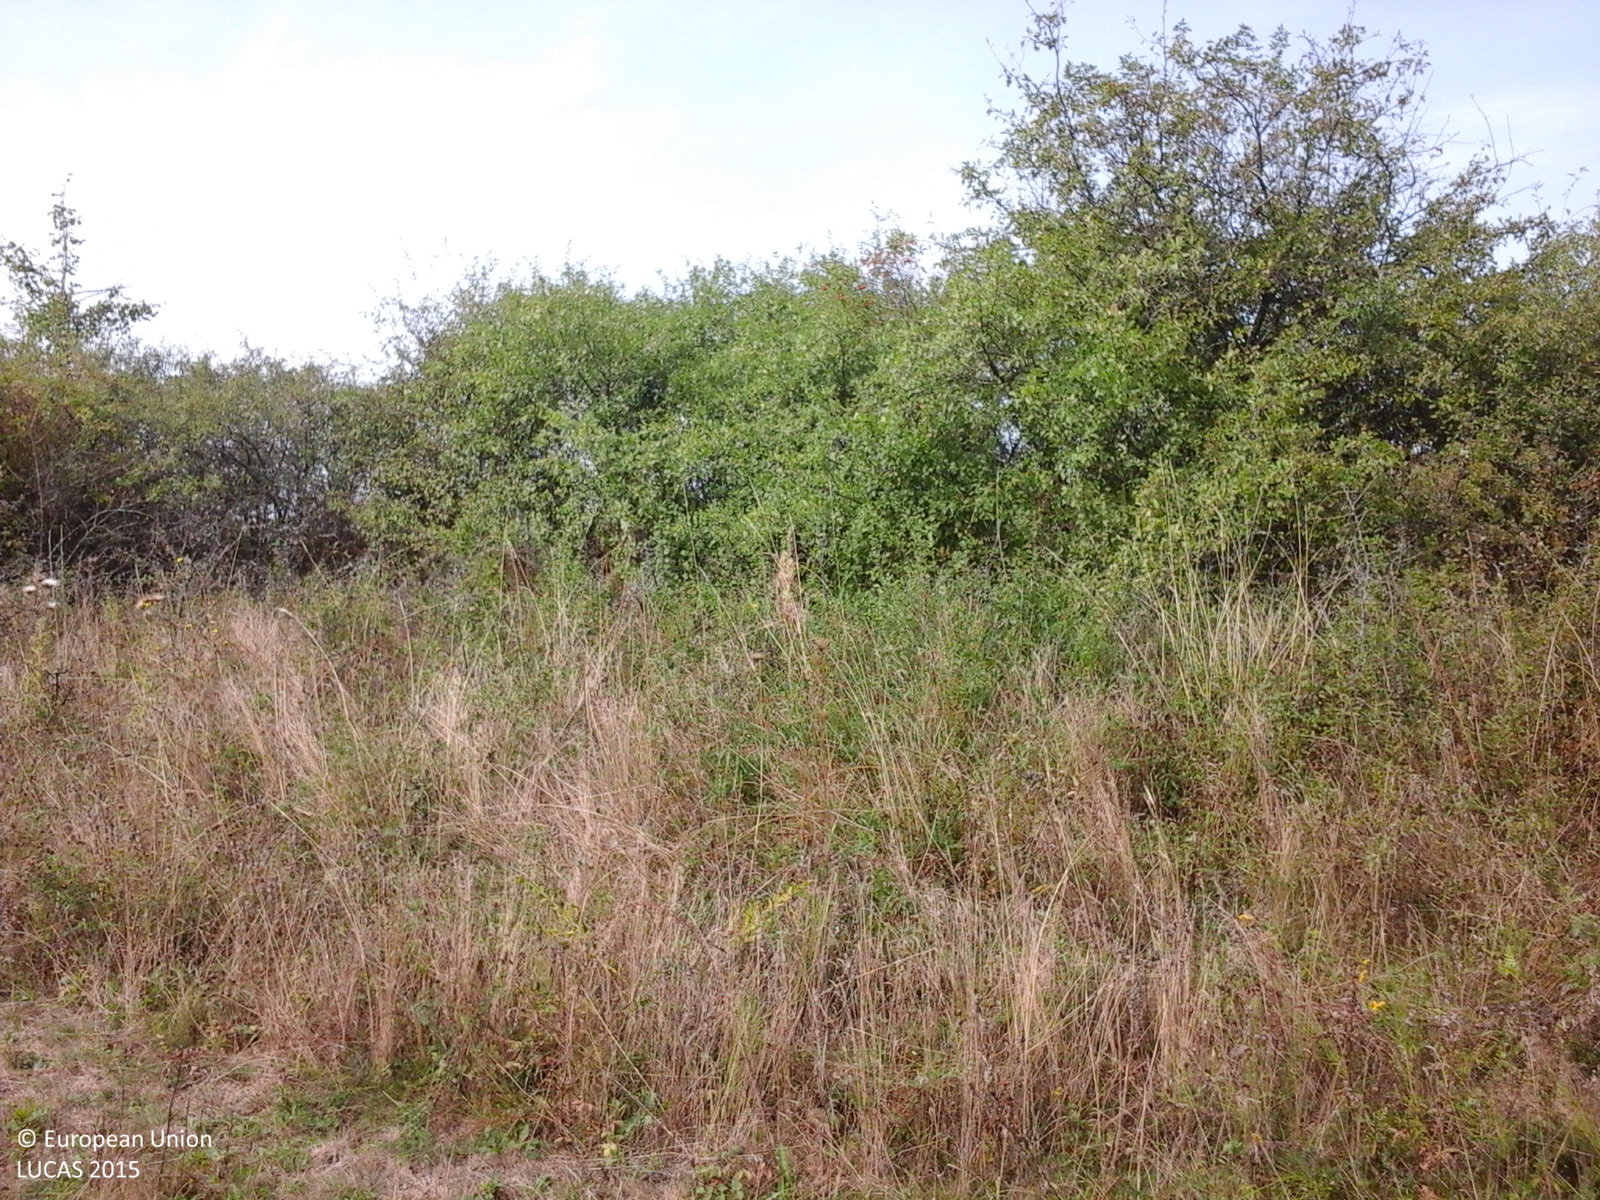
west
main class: Grassland
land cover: Grassland without tree/shrub cover
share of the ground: > 75 %
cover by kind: herbaceous plants 100 %
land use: Agriculture (excluding fallow land and kitchen gardens)
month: September
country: RO
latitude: 47.1335
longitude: 23.6405
